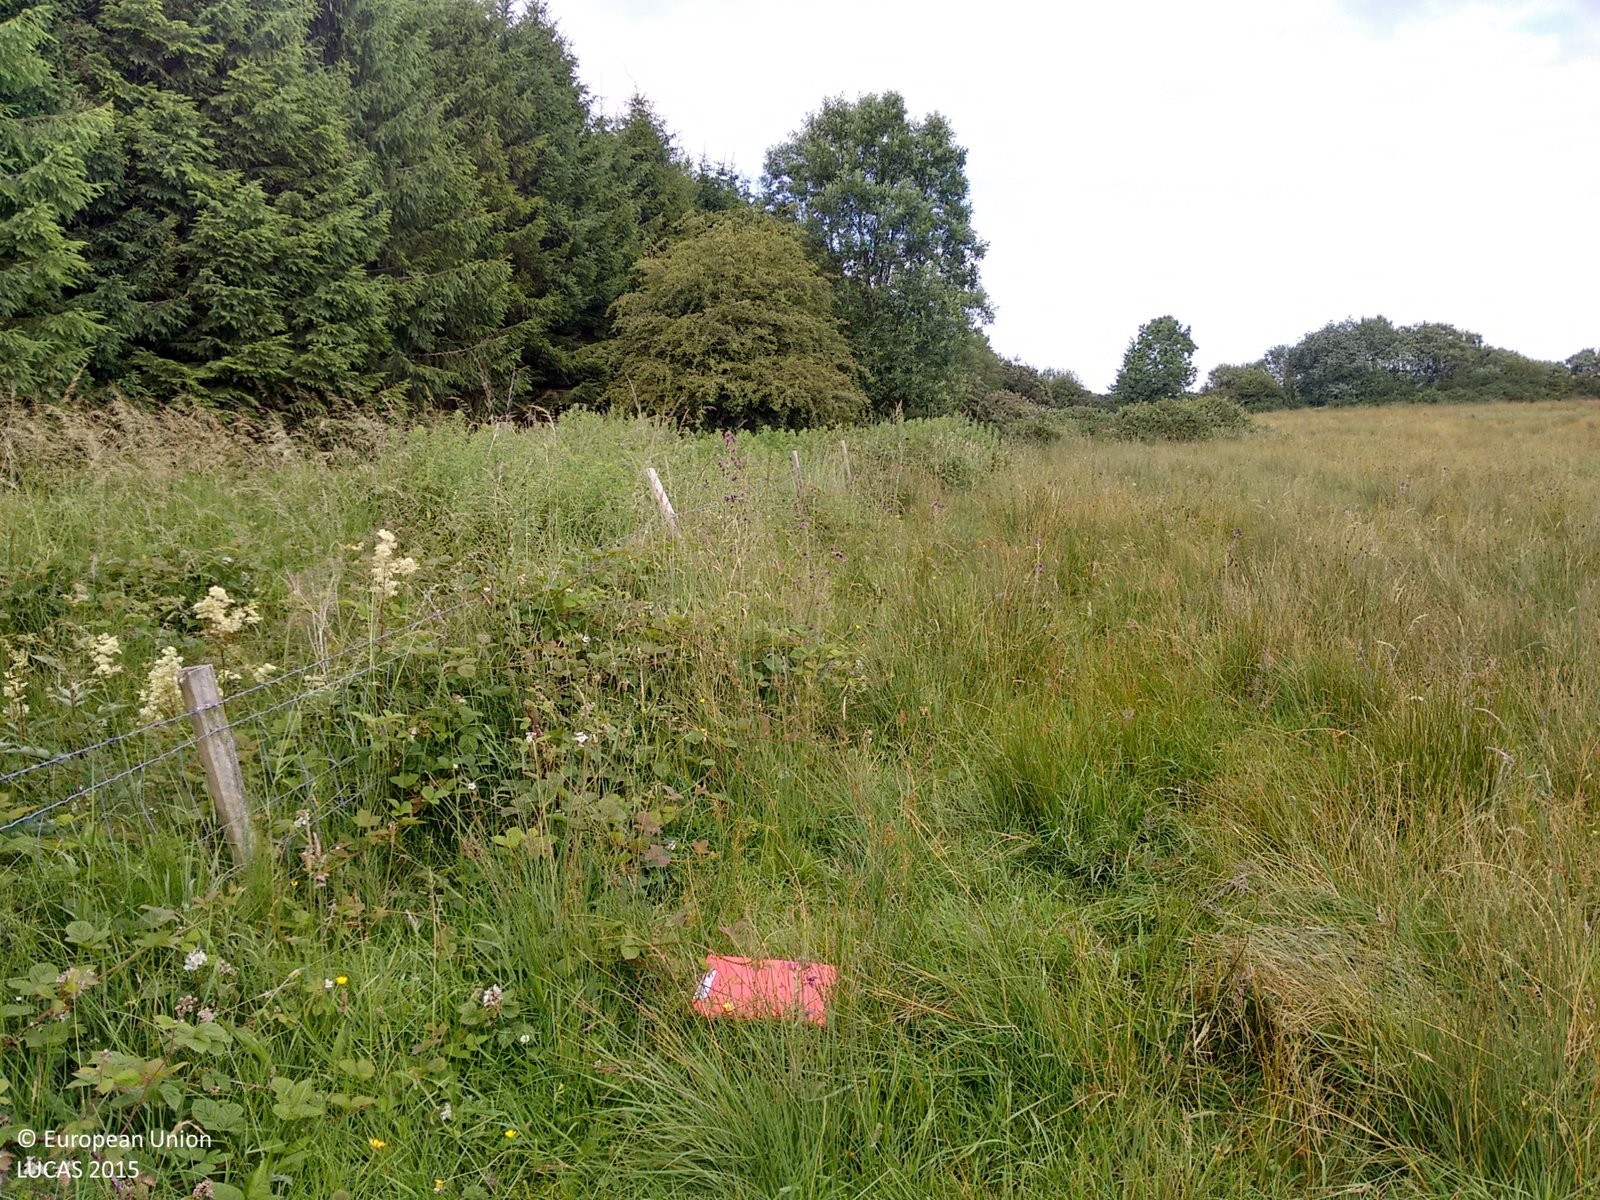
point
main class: Woodland
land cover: Pine dominated coniferous woodland
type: exotic forest
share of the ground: > 75 %
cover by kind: coniferous forest trees 90 %, broadleaved forest trees 5 %, shrubs 5 %
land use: Forestry
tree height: > 5 m
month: July
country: IE
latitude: 53.6240
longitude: -7.7504
